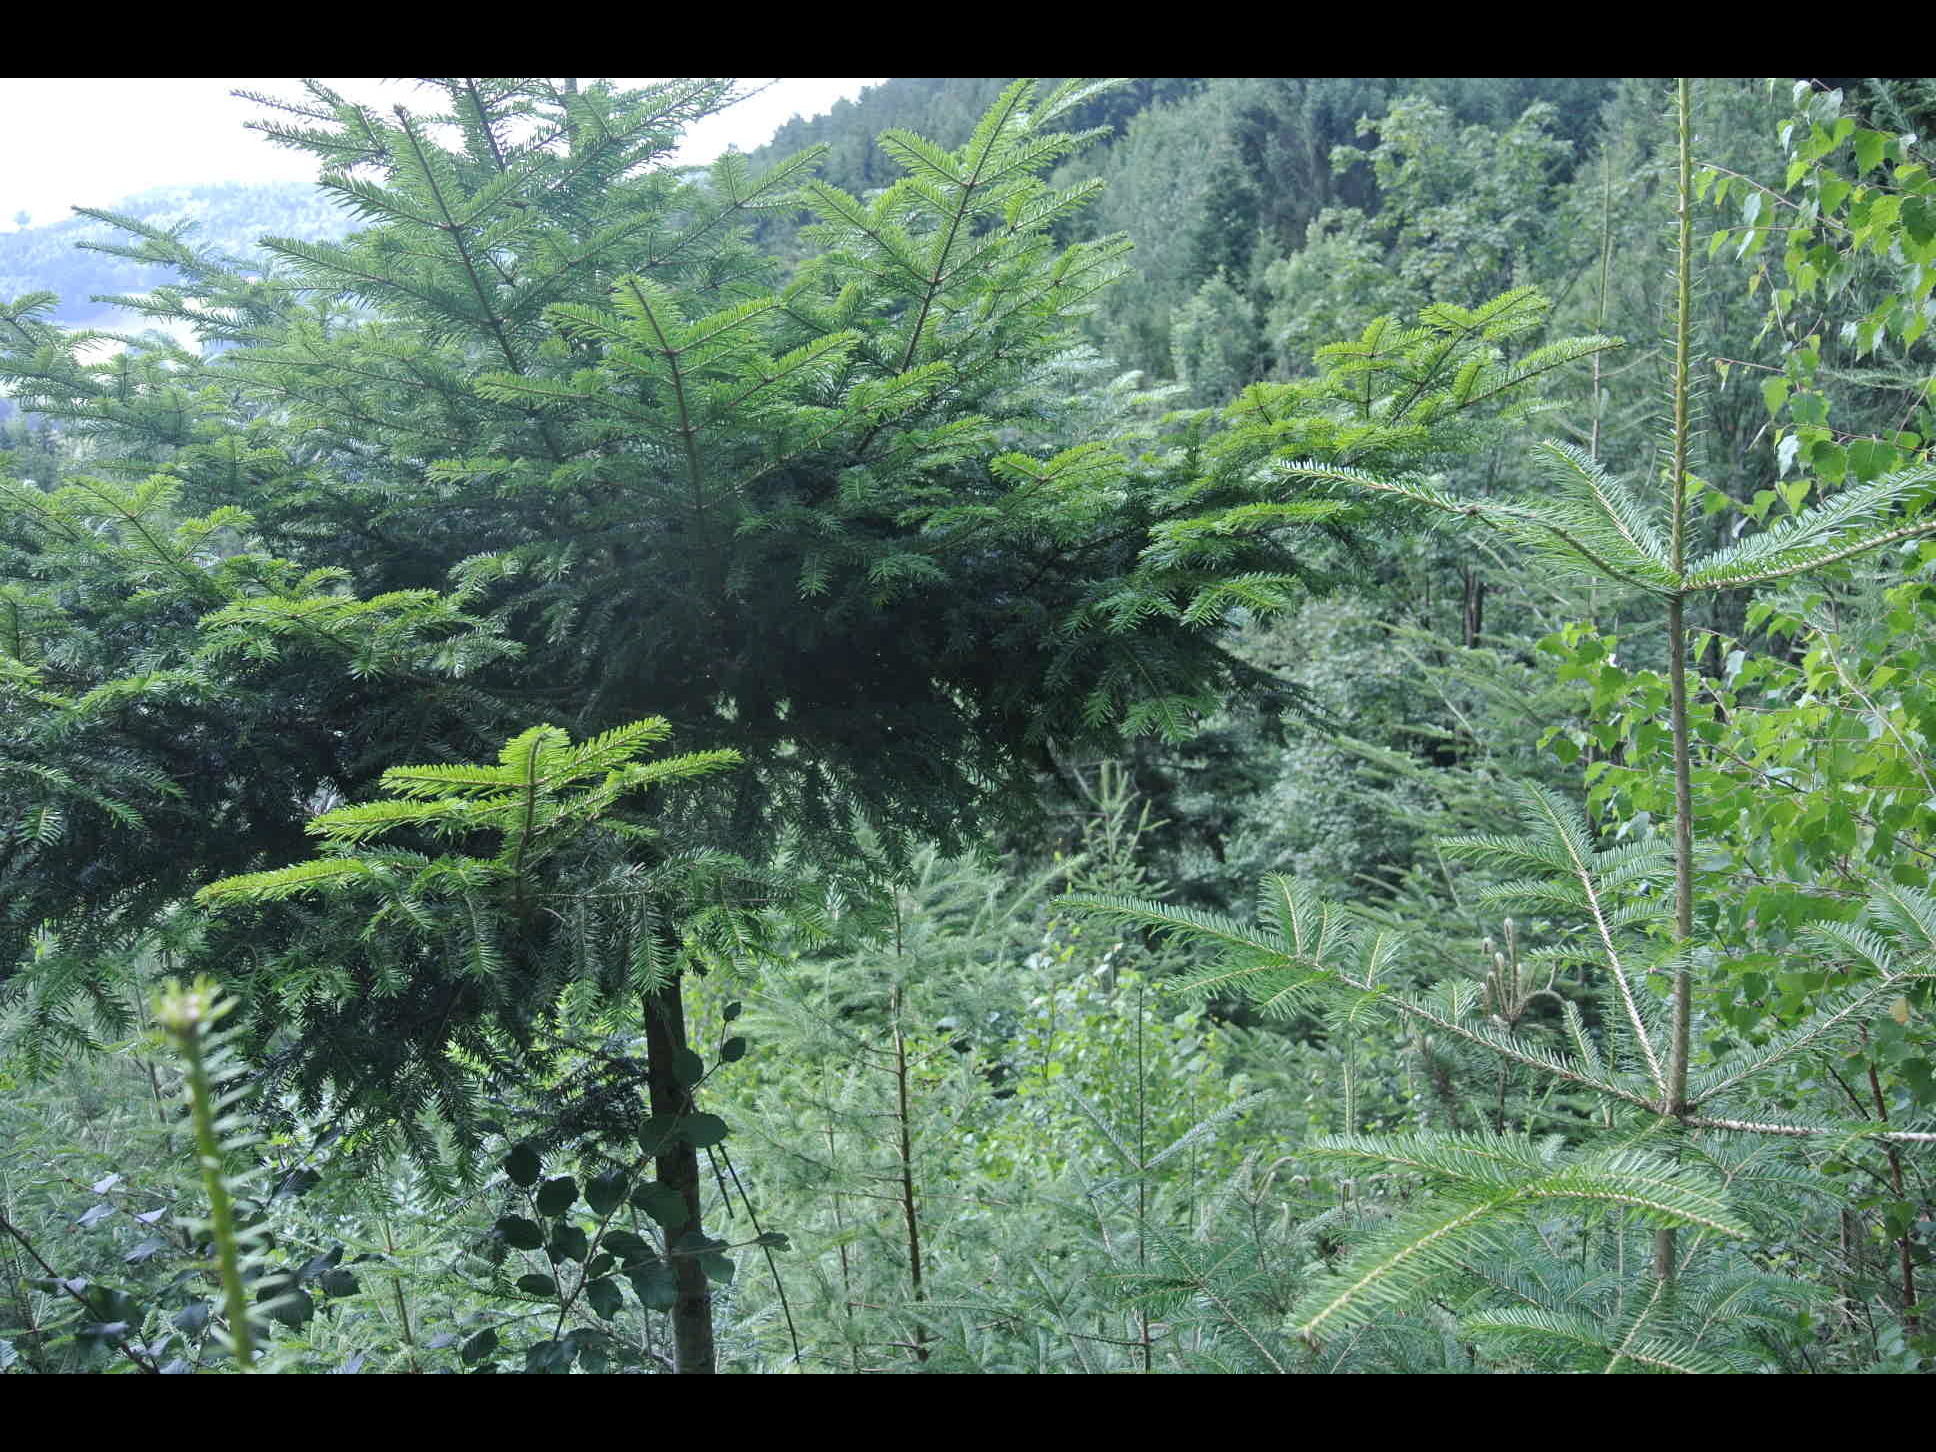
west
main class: Woodland
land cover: Spruce dominated mixed woodland
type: alpine coniferous forest
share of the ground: > 75 %
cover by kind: broadleaved forest trees 60 %, coniferous forest trees 40 %
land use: Forestry
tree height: < 5 m
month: July
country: AT
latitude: 47.5821
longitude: 16.1589
